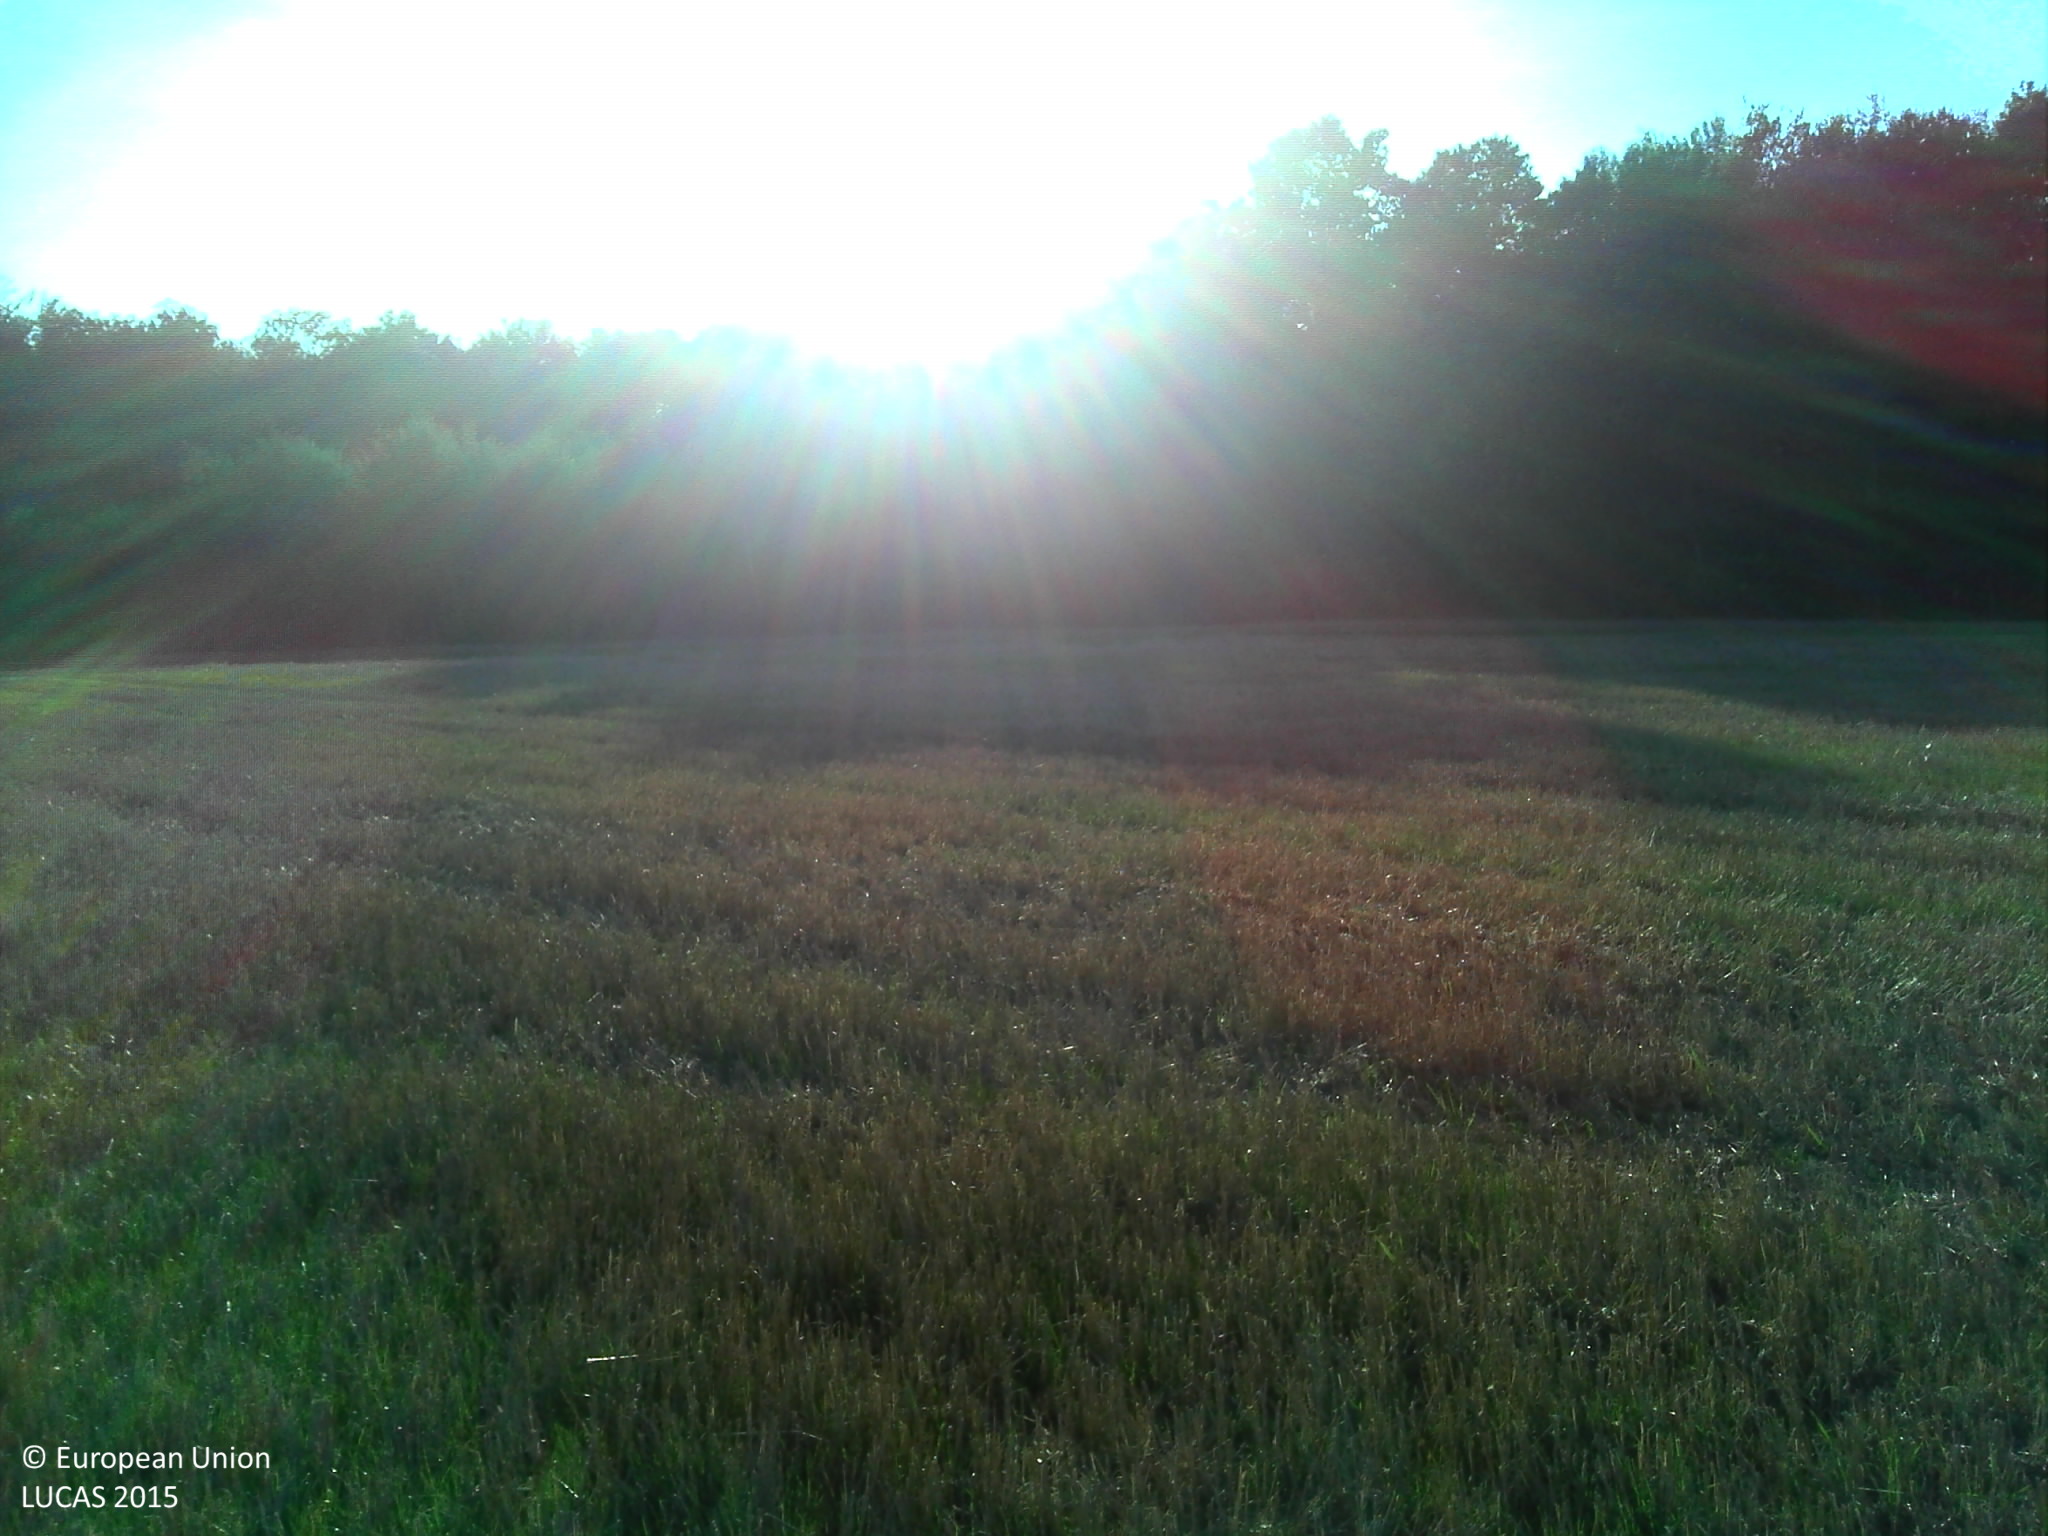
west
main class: Cropland
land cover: Common wheat
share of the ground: > 75 %
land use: Agriculture (excluding fallow land and kitchen gardens)
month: September
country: FR
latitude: 47.0284
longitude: 1.5273
